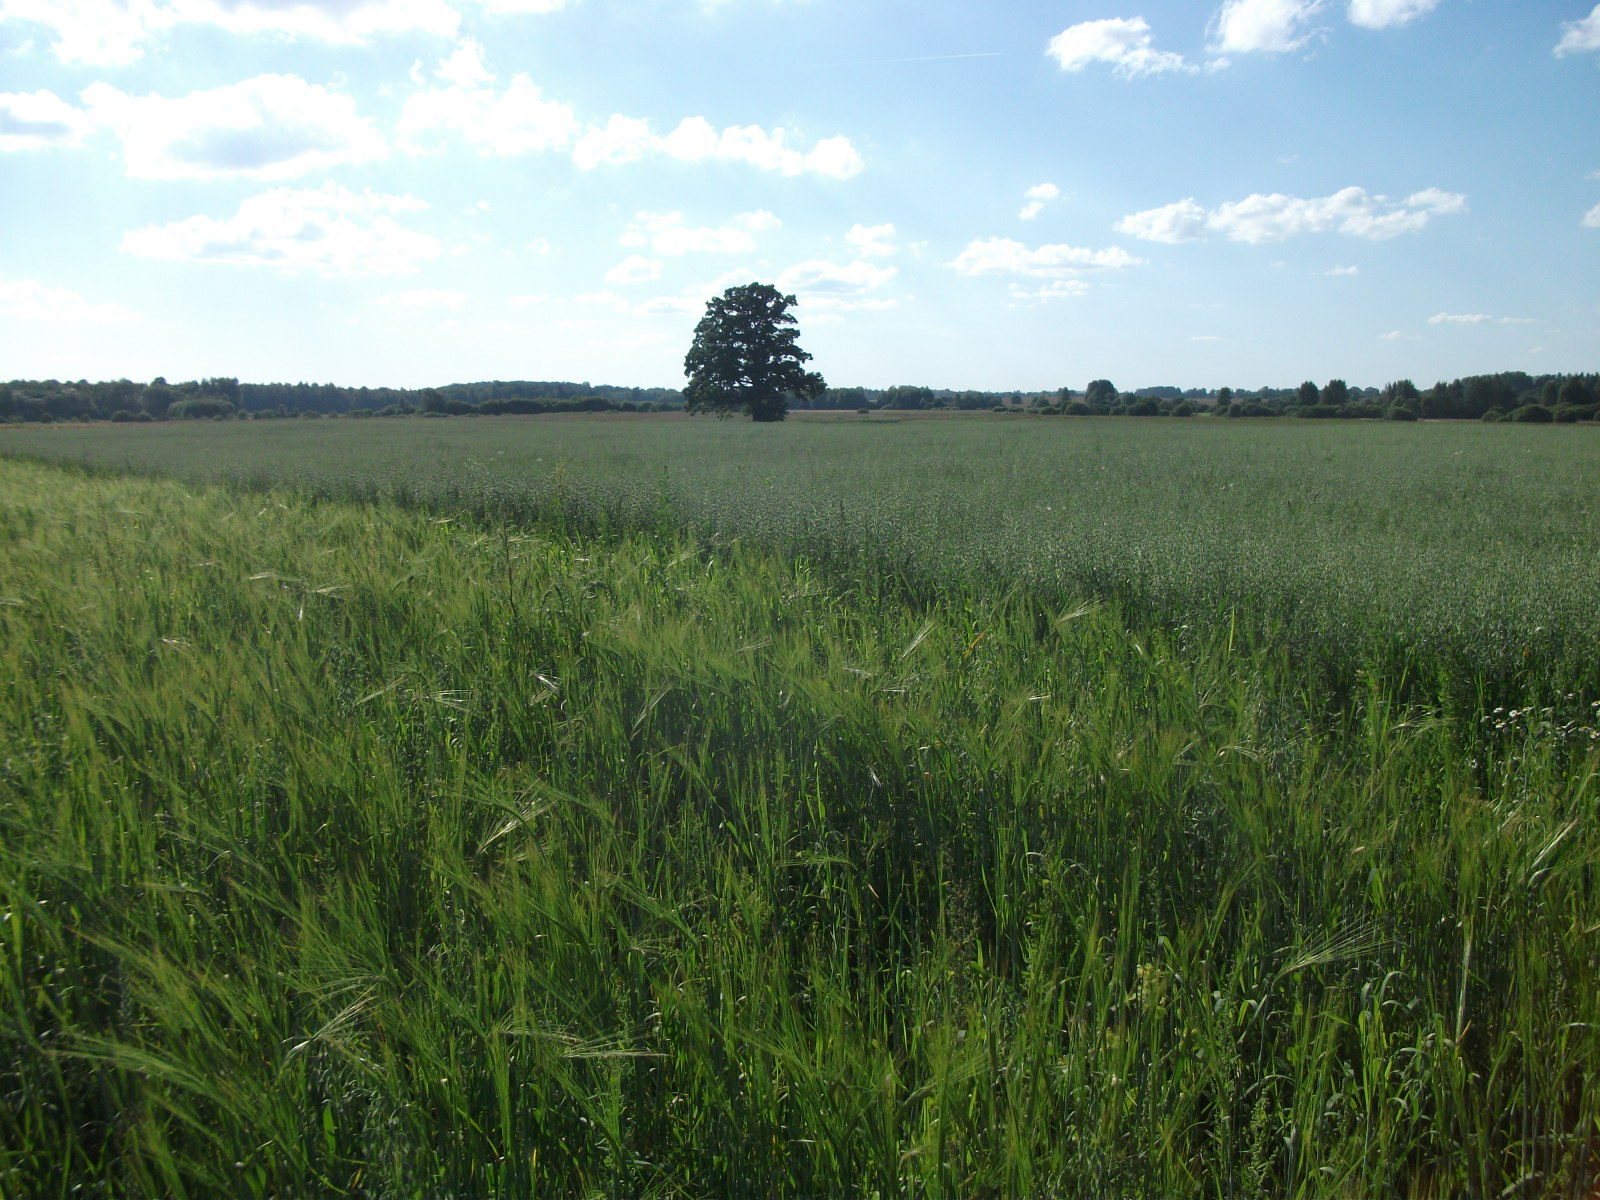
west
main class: Cropland
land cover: Barley
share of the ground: > 75 %
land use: Agriculture (excluding fallow land and kitchen gardens)
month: August
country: LV
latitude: 57.0449
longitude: 26.6146
